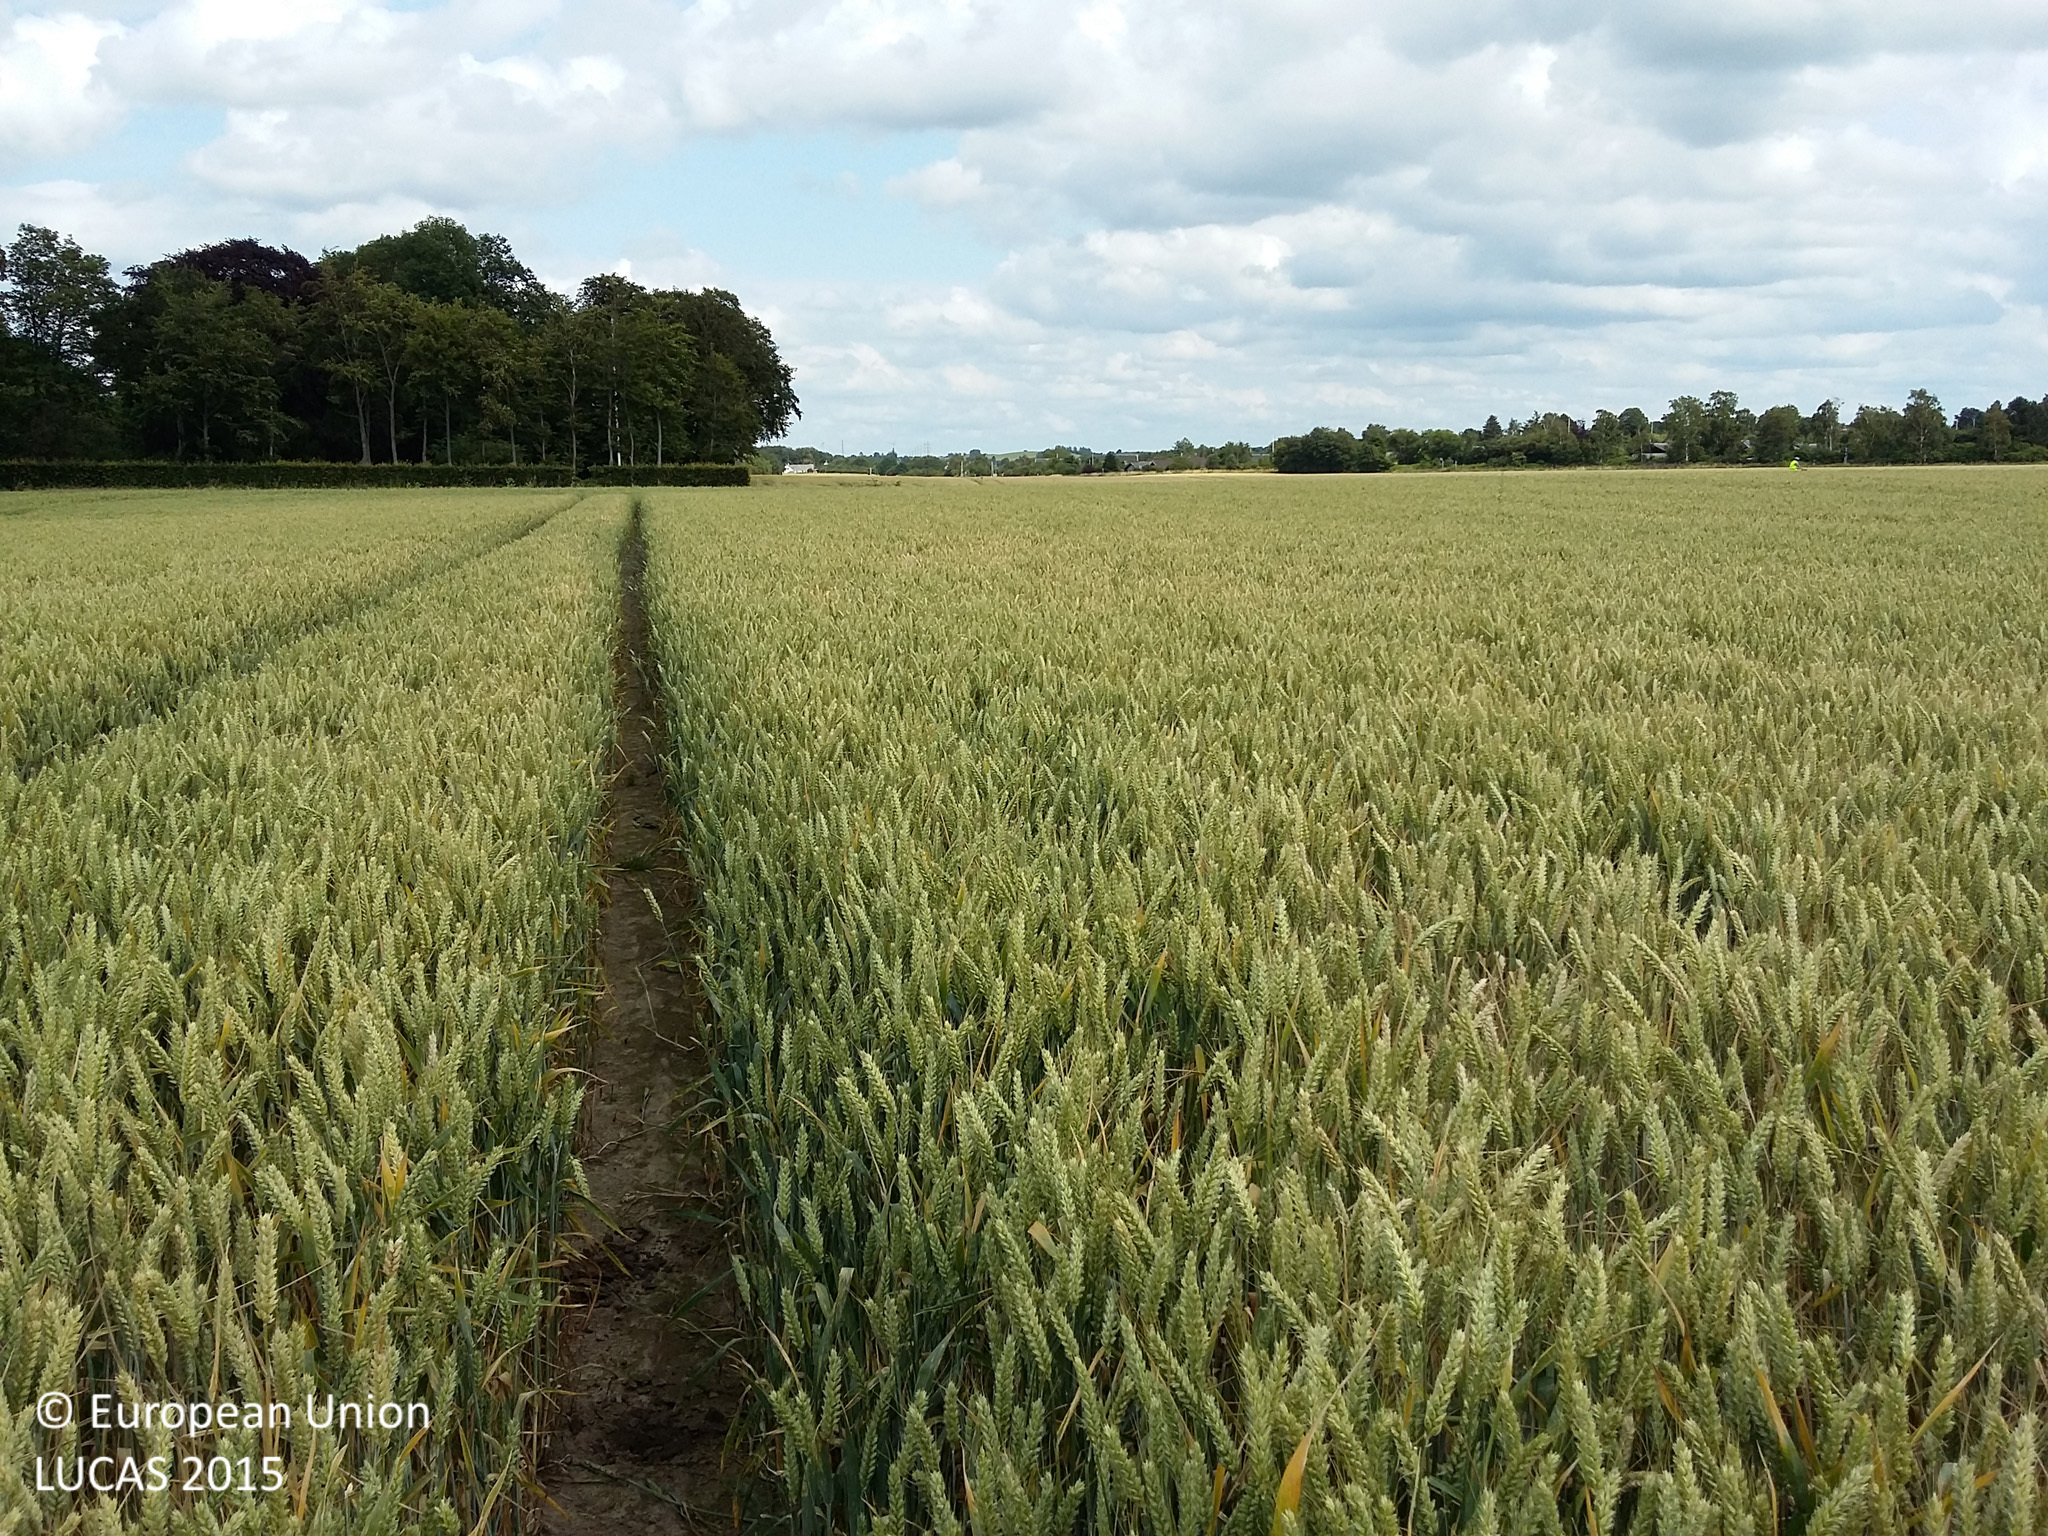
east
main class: Cropland
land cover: Common wheat
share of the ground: > 75 %
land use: Agriculture (excluding fallow land and kitchen gardens)
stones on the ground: < 10 %
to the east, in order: Common wheat; Grass margins; Paved roads, cycling and walking lanes; Spontaneously vegetated surfaces; Barley
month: July
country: DK
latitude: 55.5162
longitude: 11.2816
